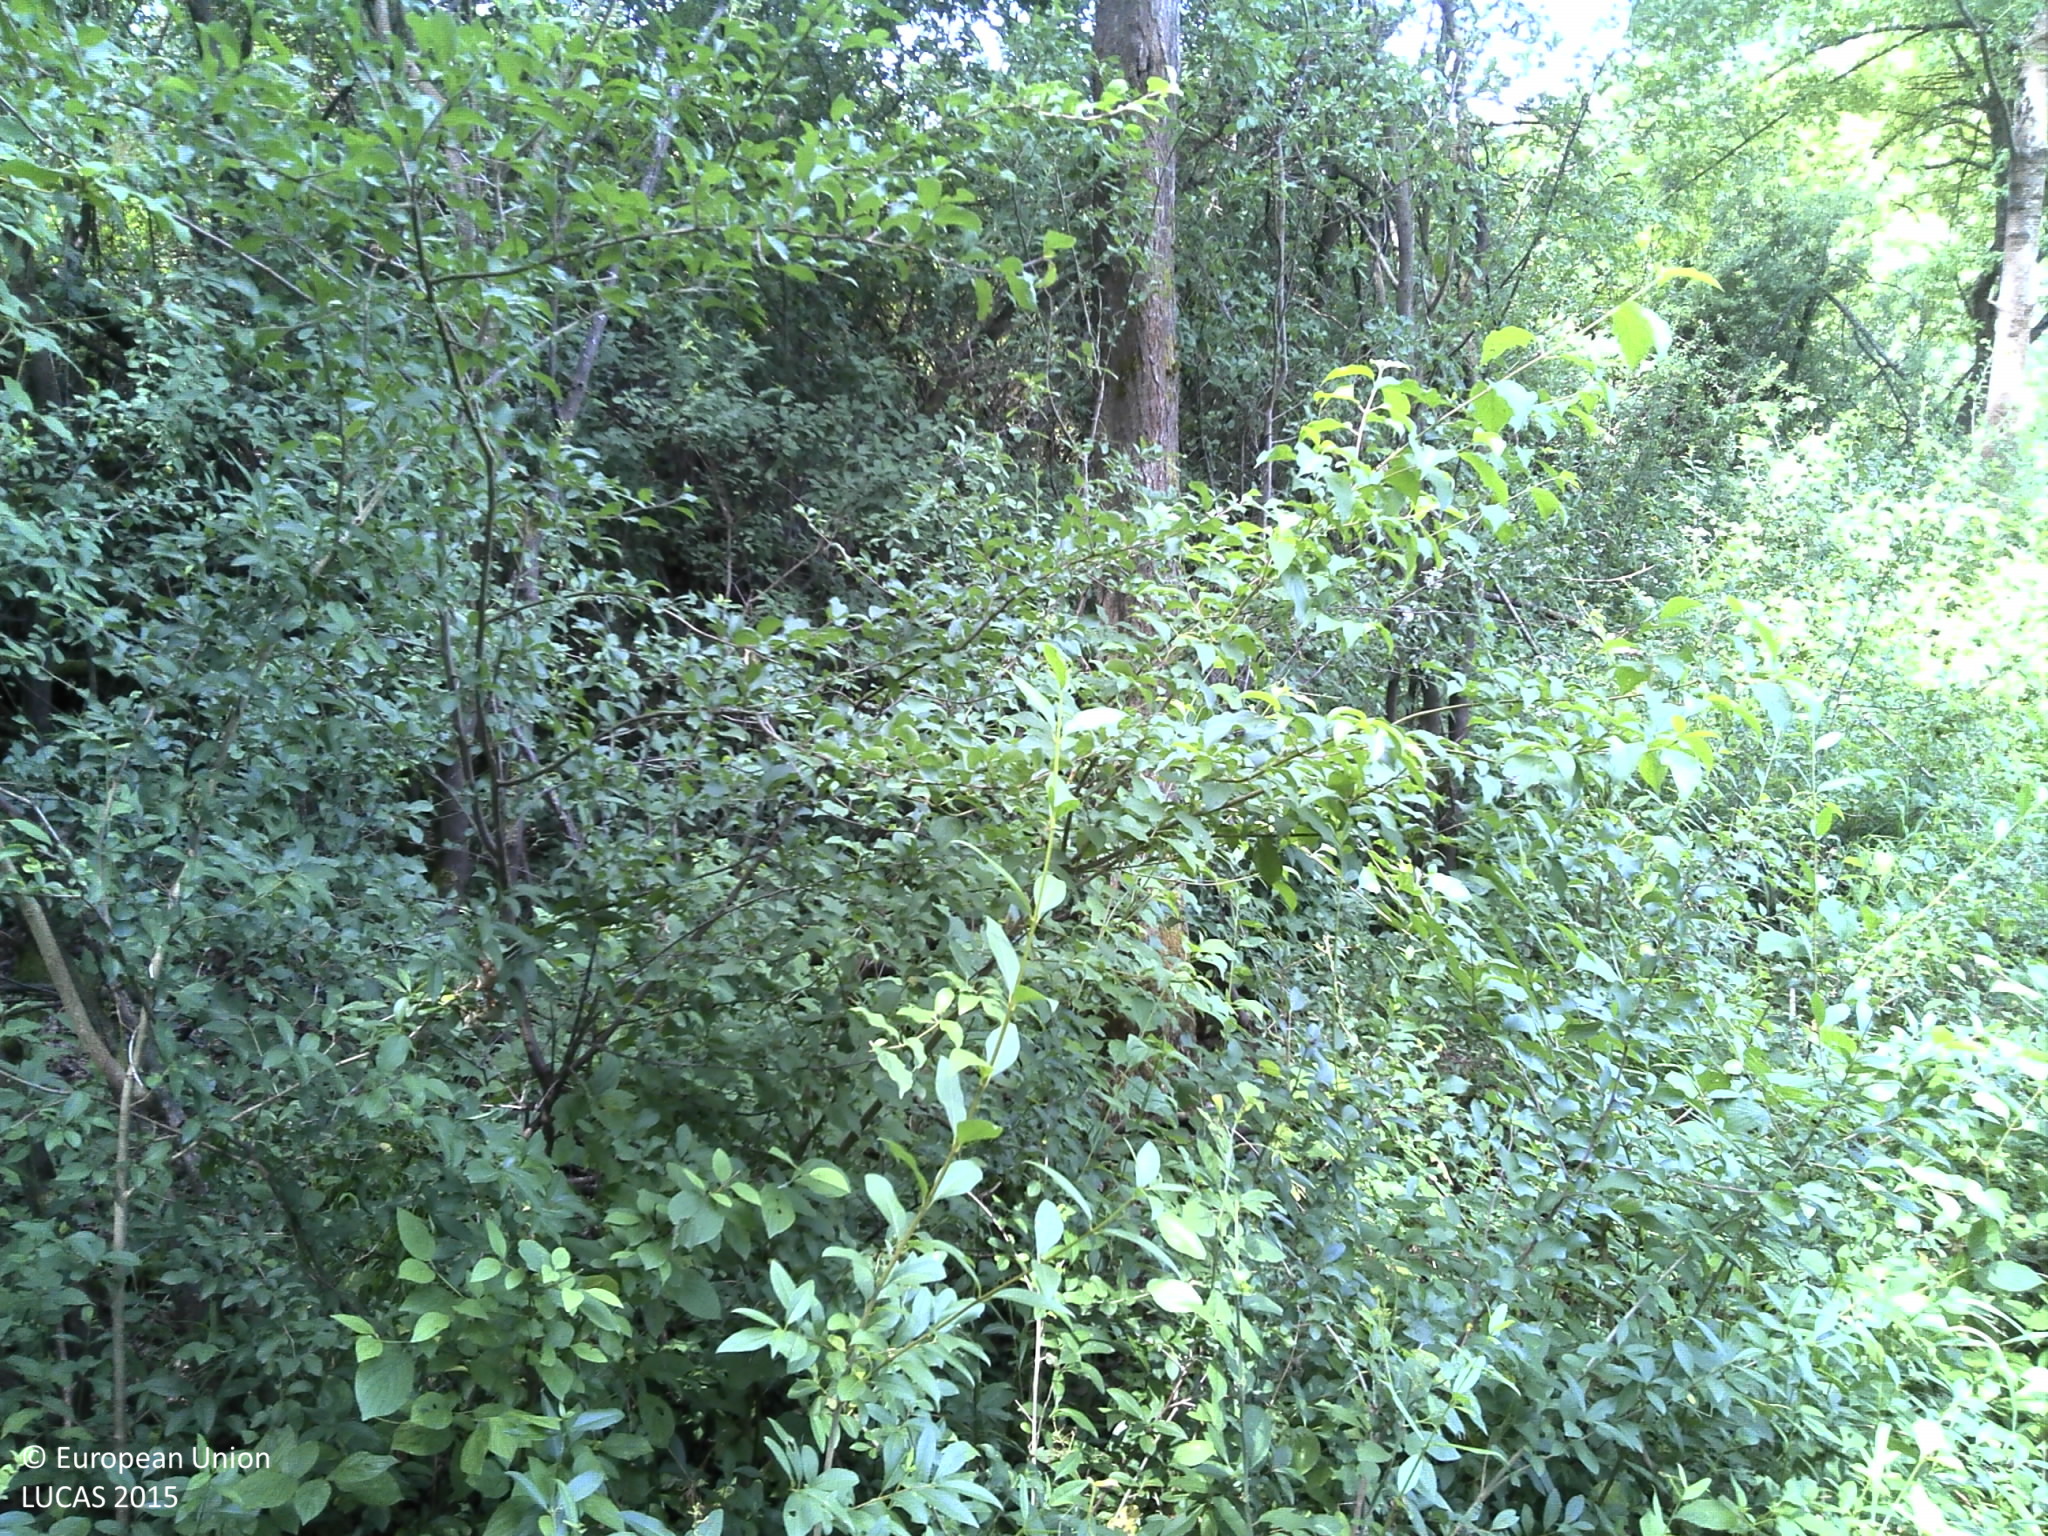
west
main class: Woodland
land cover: Broadleaved woodland
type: acidophilous oak and oak-birch forest
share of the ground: 50 - 75 %
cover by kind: broadleaved forest trees 75 %, shrubs 25 %
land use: Forestry
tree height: > 5 m
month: June
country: HR
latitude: 45.1019
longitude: 17.8680
